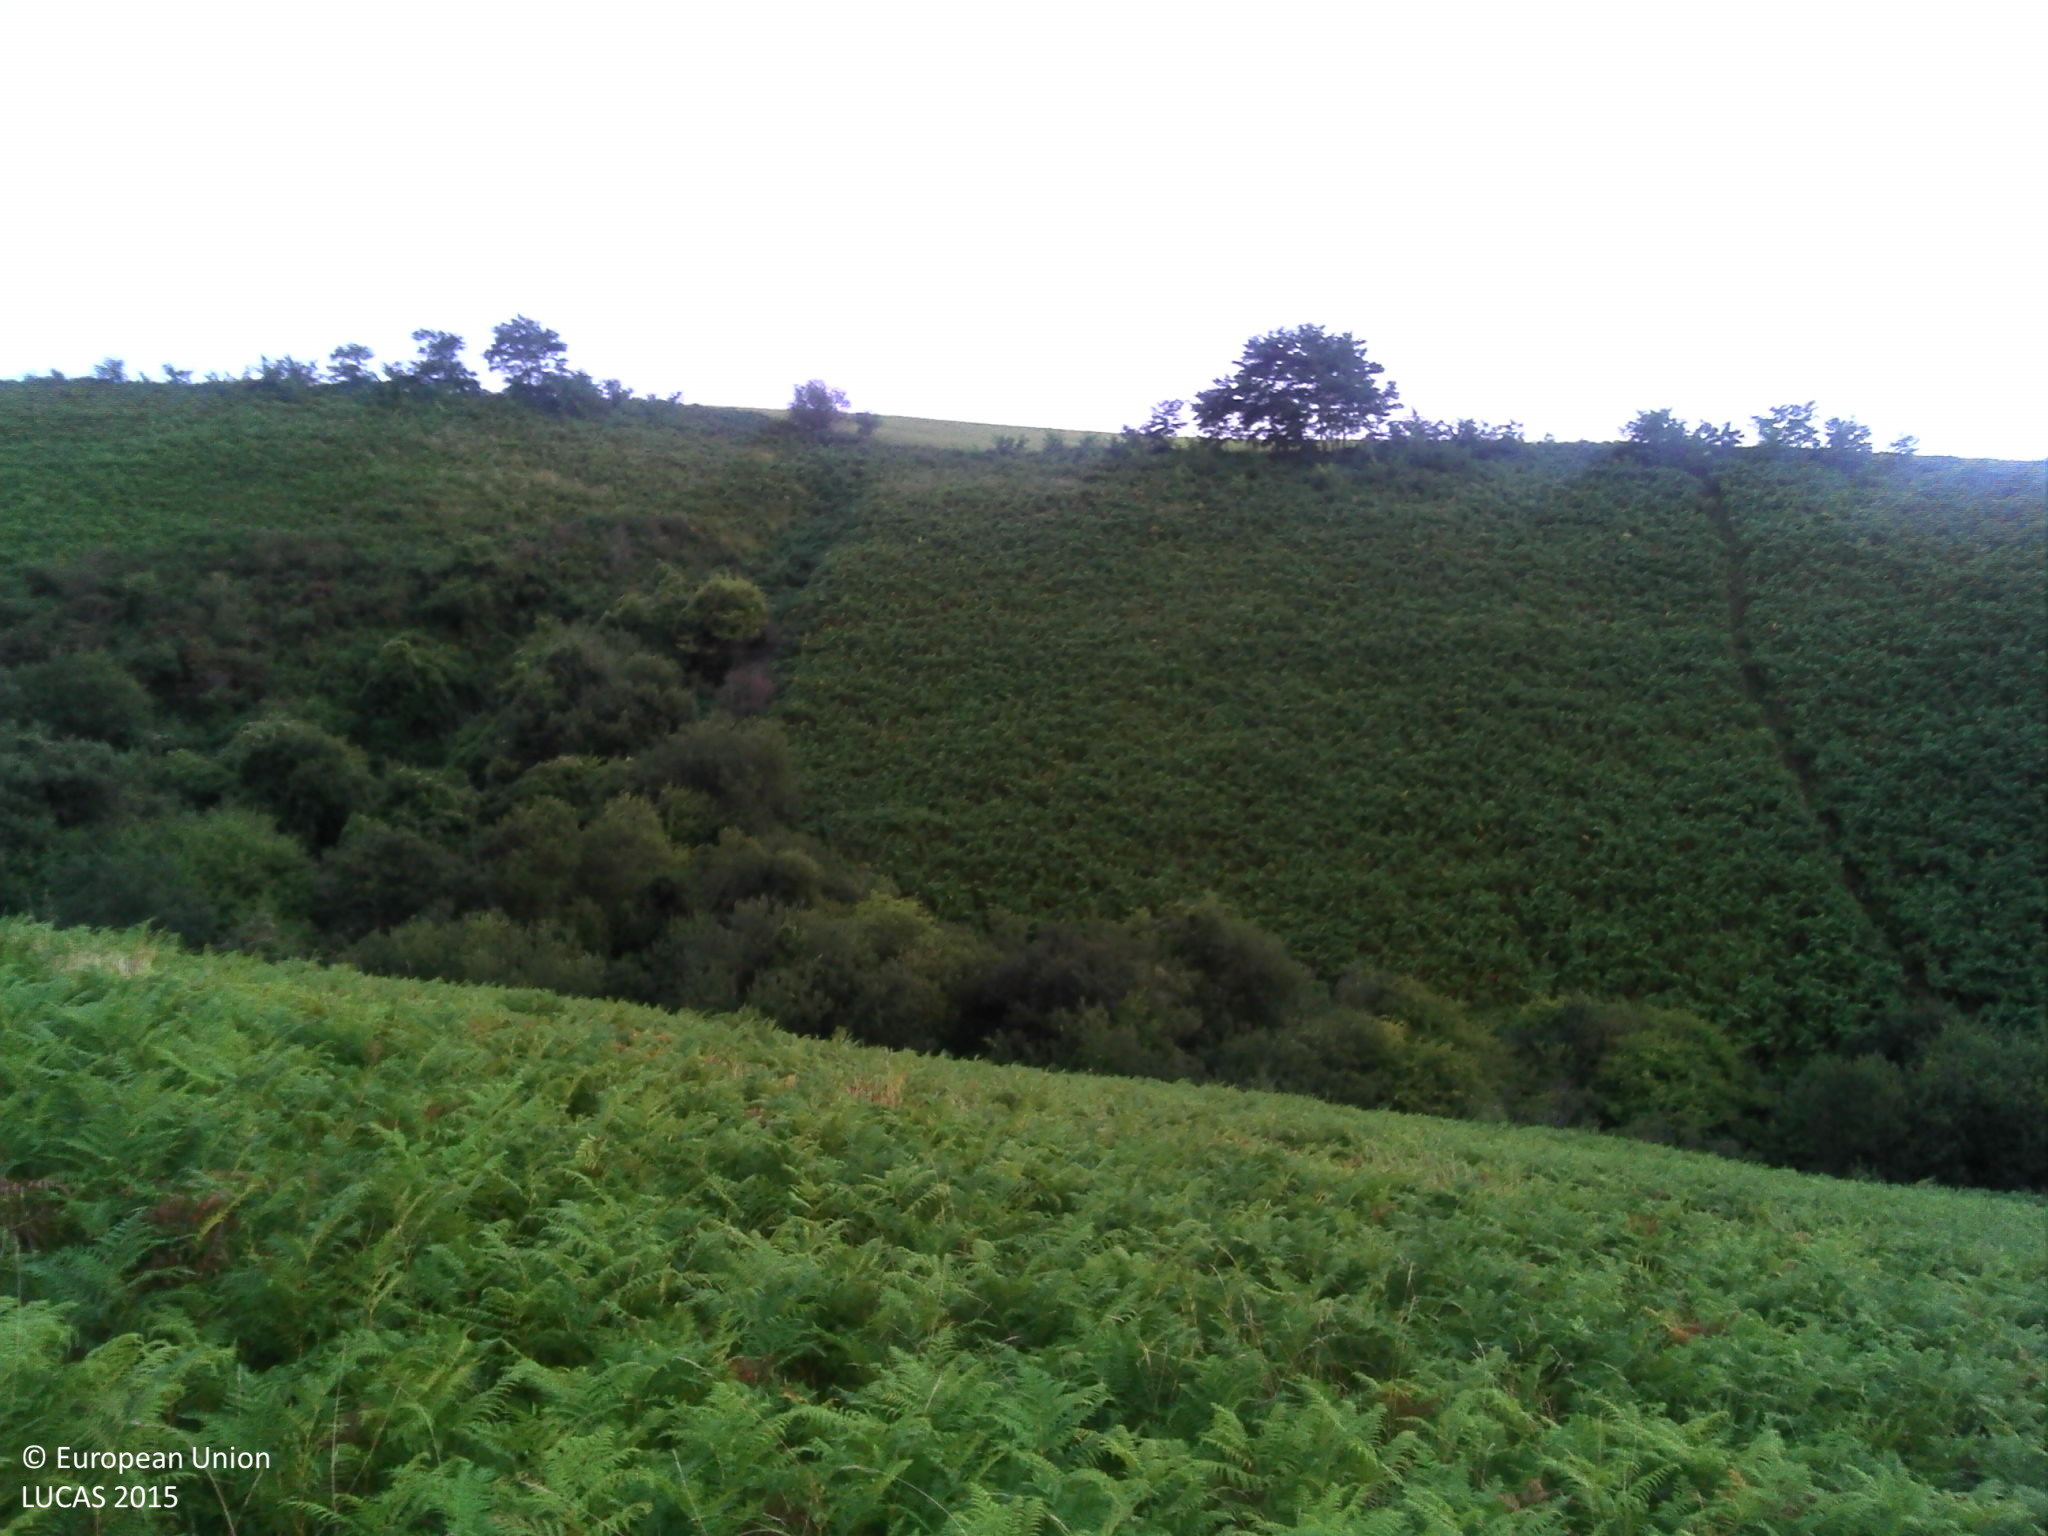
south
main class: Grassland
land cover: Grassland without tree/shrub cover
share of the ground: > 75 %
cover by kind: herbaceous plants 100 %
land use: Agriculture (excluding fallow land and kitchen gardens)
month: August
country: FR
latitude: 43.3799
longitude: -1.1850
